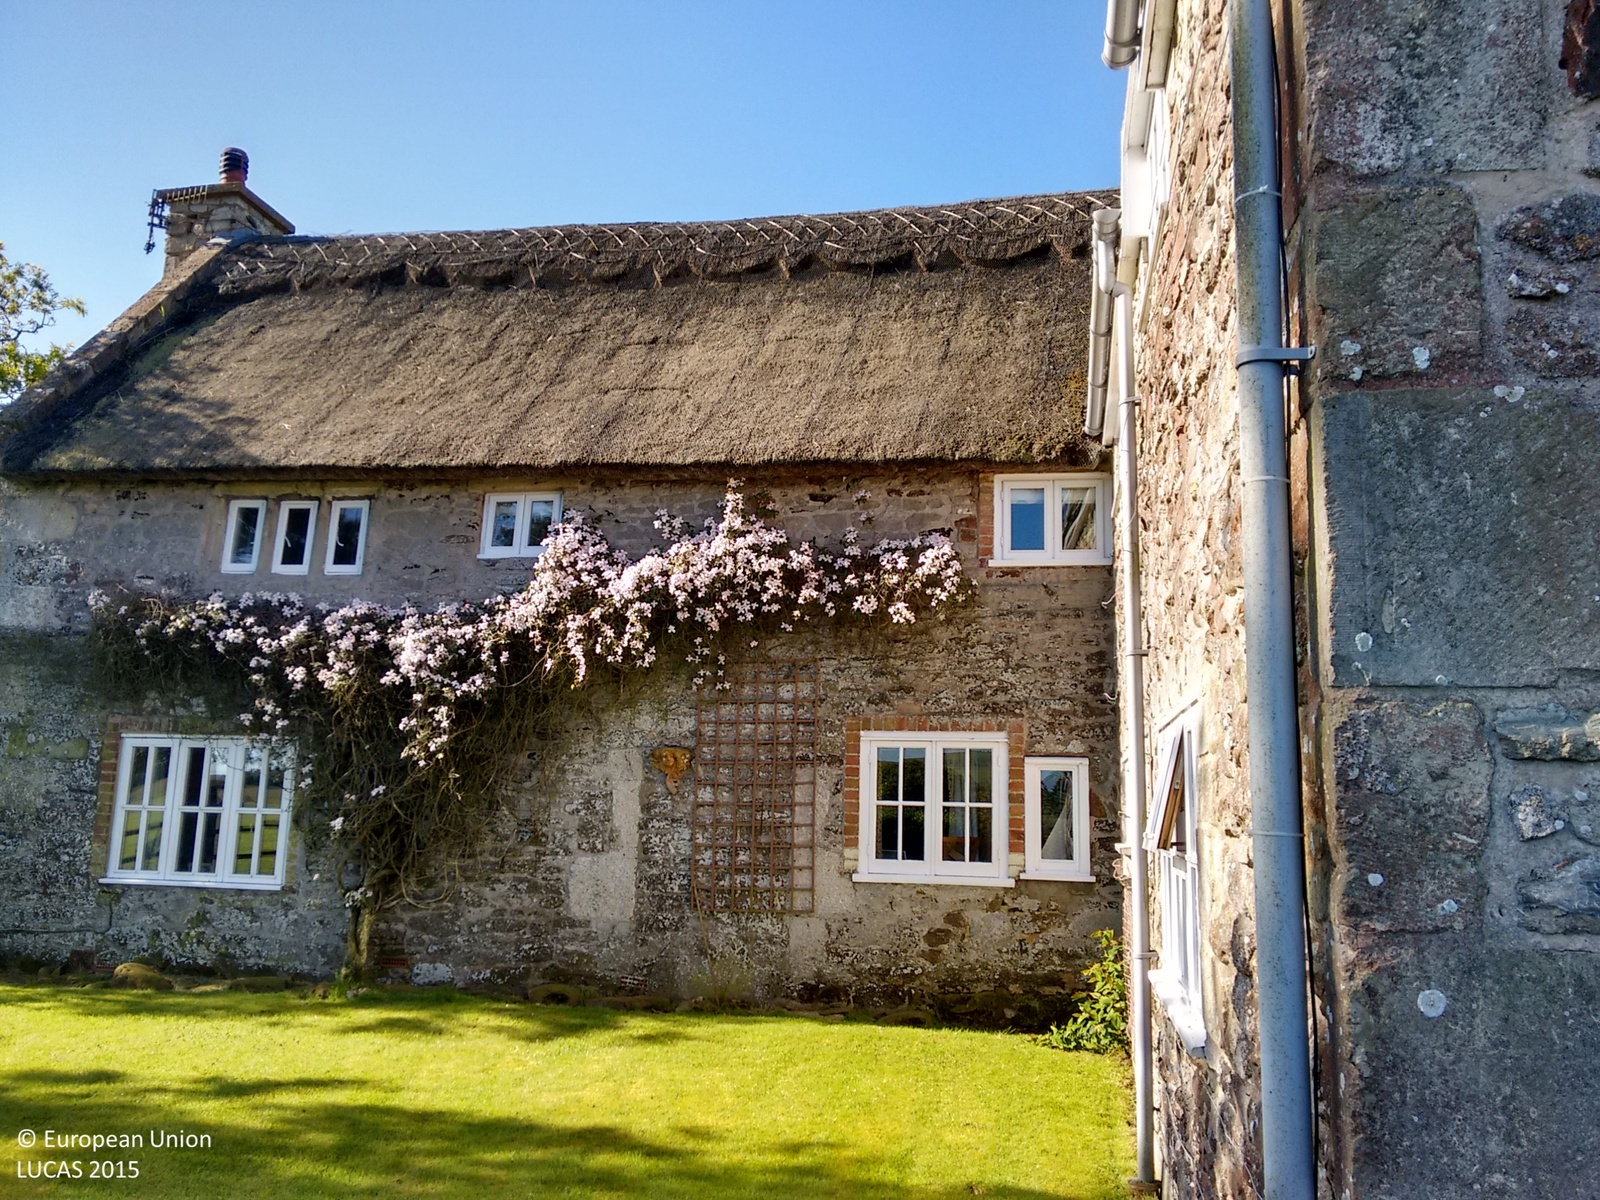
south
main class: Grassland
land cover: Grassland with sparse tree/shrub cover
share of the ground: > 75 %
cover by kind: herbaceous plants 95 %, broadleaved forest trees 5 %
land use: Residential
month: May
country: GB
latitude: 50.6302
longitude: -1.3731
